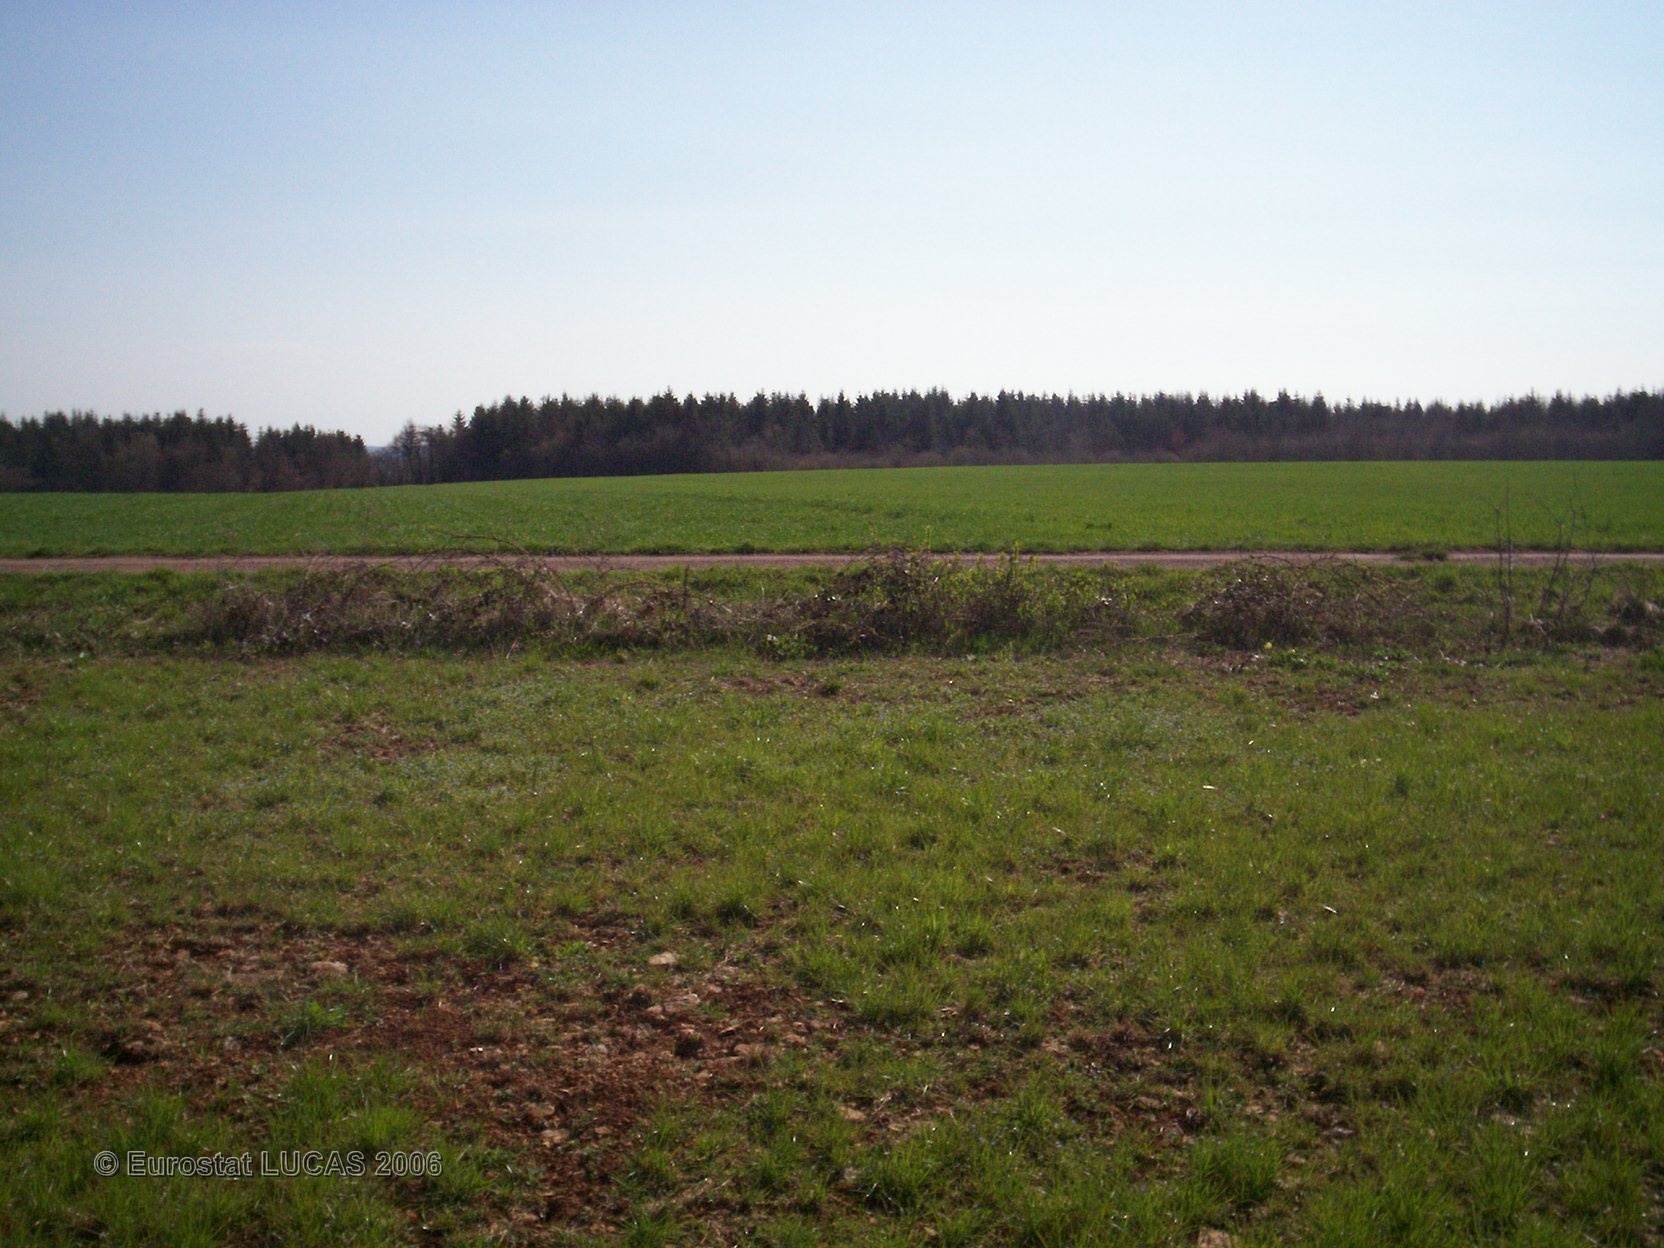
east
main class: Grassland
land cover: Grassland without tree/shrub cover
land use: Fallow land
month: April
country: FR
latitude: 47.4228
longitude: 4.5778
